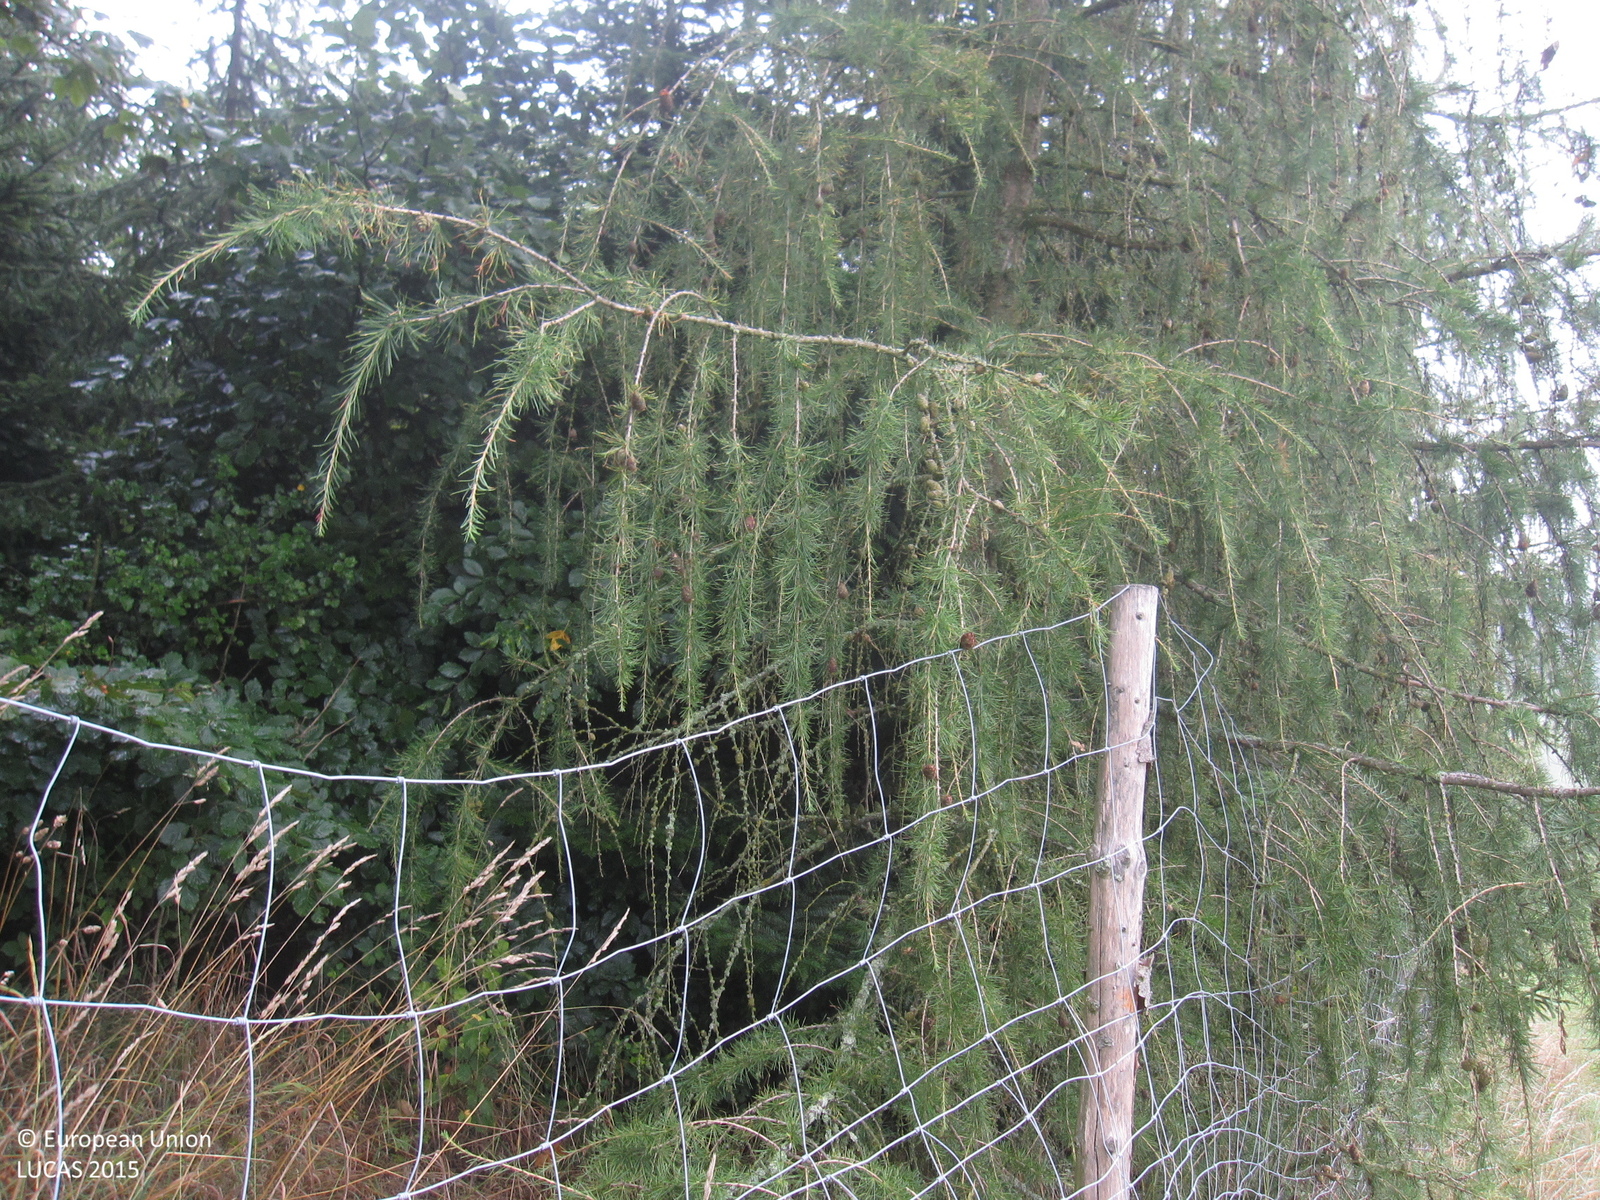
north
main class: Woodland
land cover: Spruce dominated mixed woodland
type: hemiboreal forest and nemoral coniferous forest and mixed broadleaved-coniferous forest
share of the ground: > 75 %
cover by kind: coniferous forest trees 75 %, broadleaved forest trees 25 %
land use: Forestry
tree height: > 5 m
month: August
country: DE
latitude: 50.5710
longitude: 11.4257
